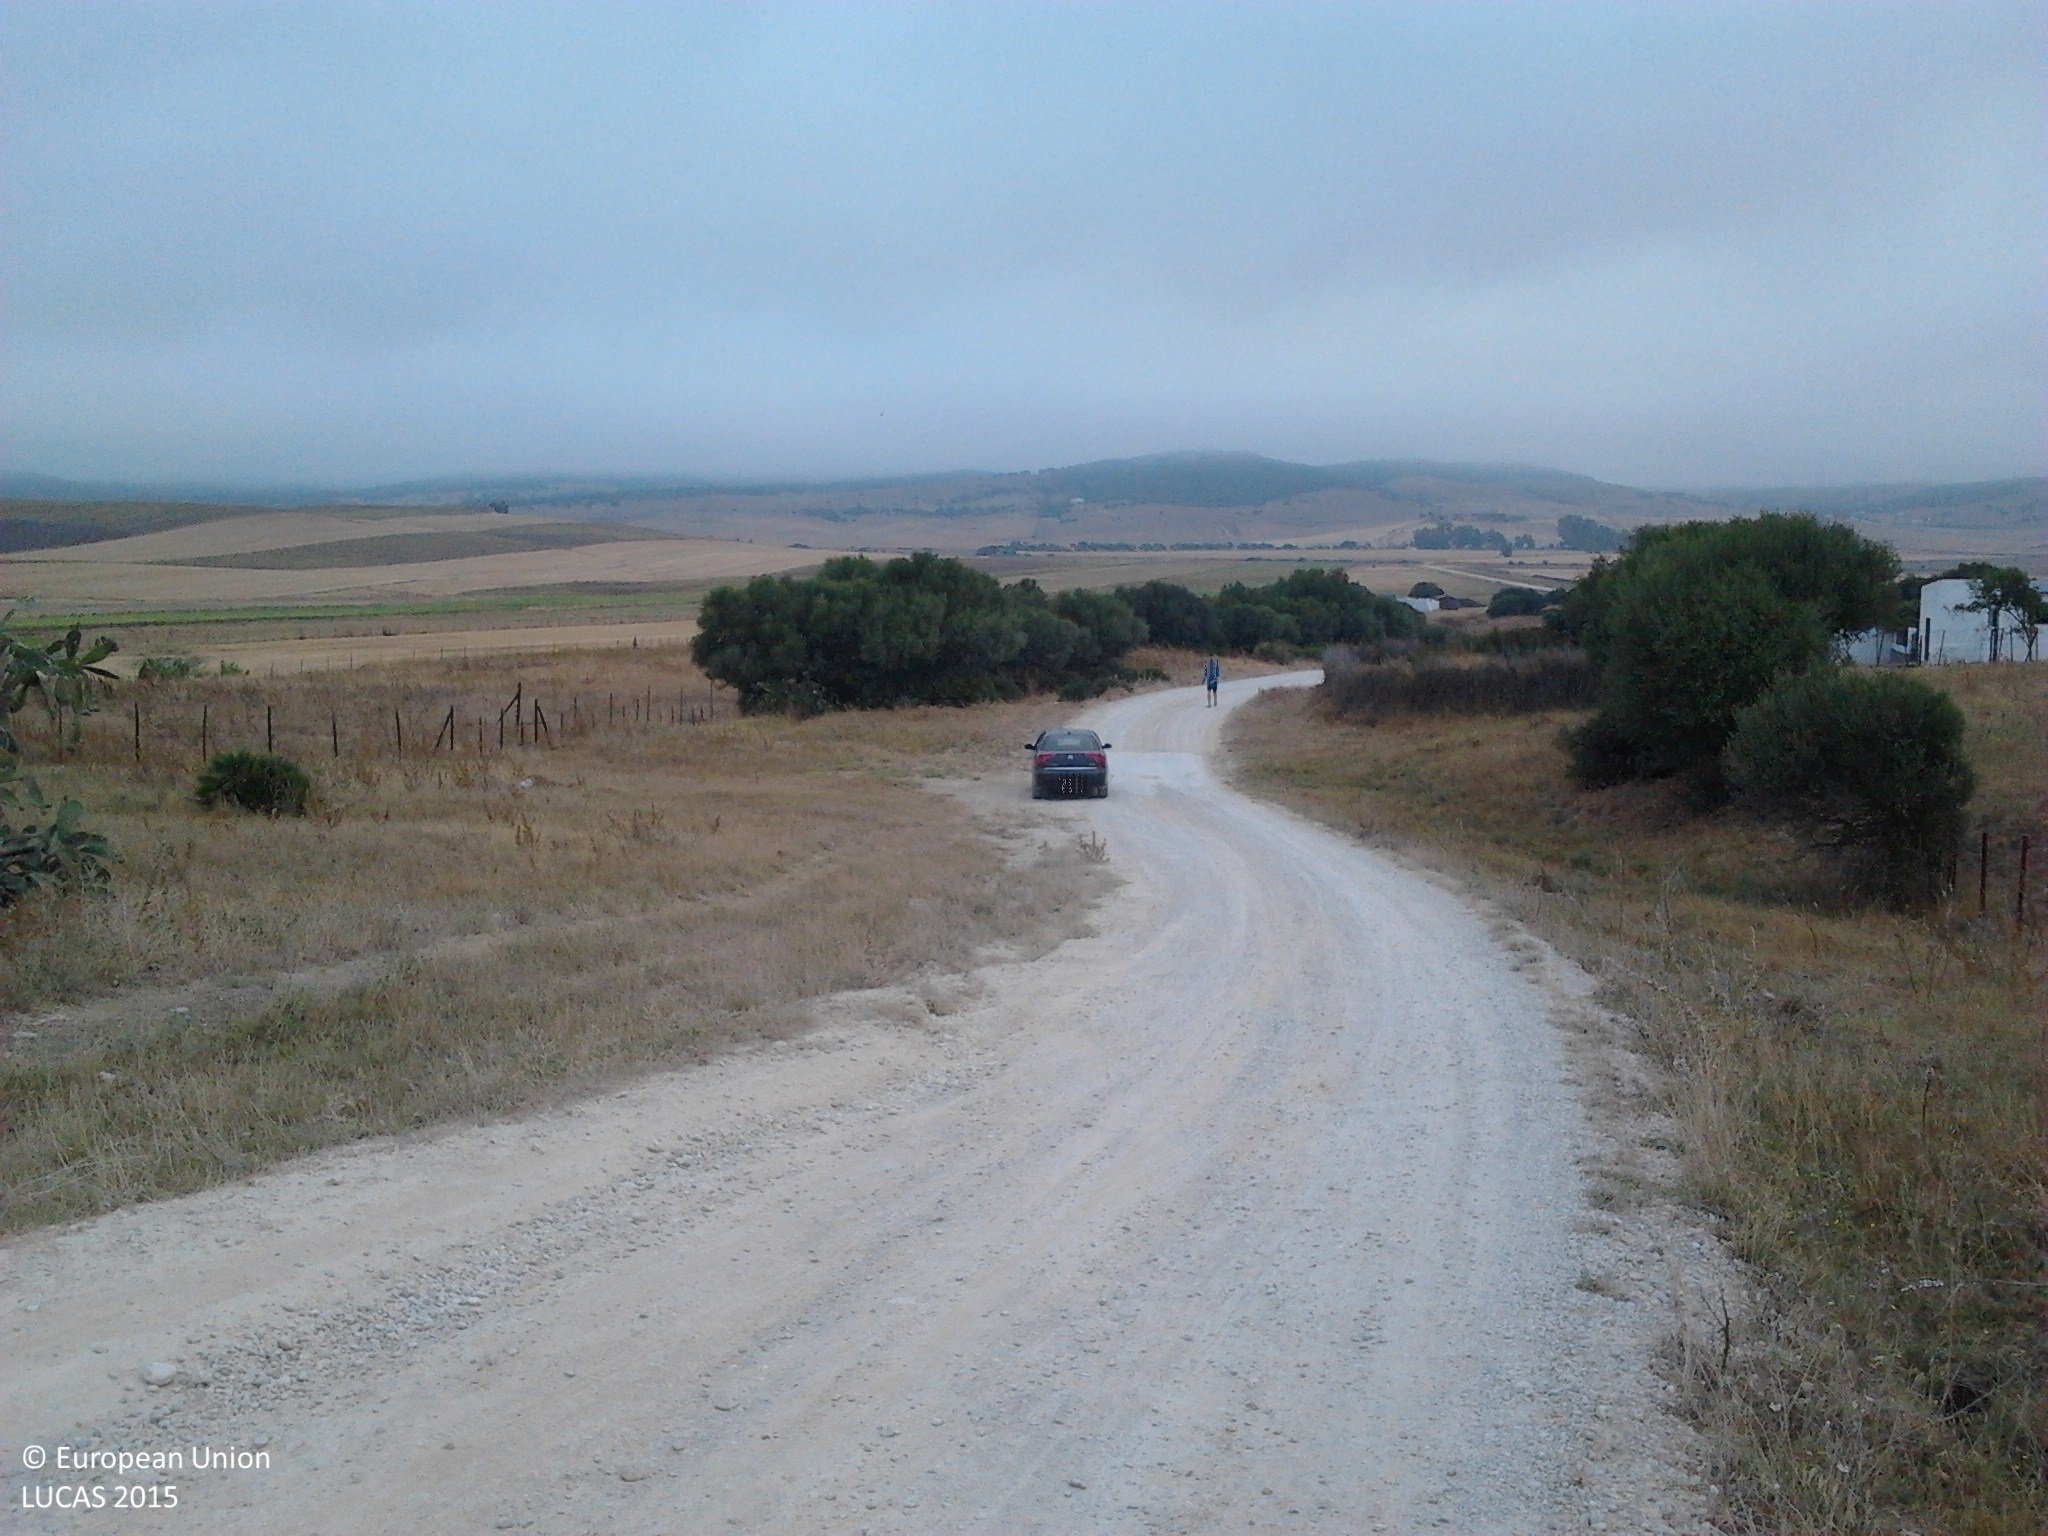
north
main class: Grassland
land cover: Grassland without tree/shrub cover
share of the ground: > 75 %
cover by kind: herbaceous plants 100 %
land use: Agriculture (excluding fallow land and kitchen gardens)
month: July
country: ES
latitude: 36.3561
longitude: -5.8363
